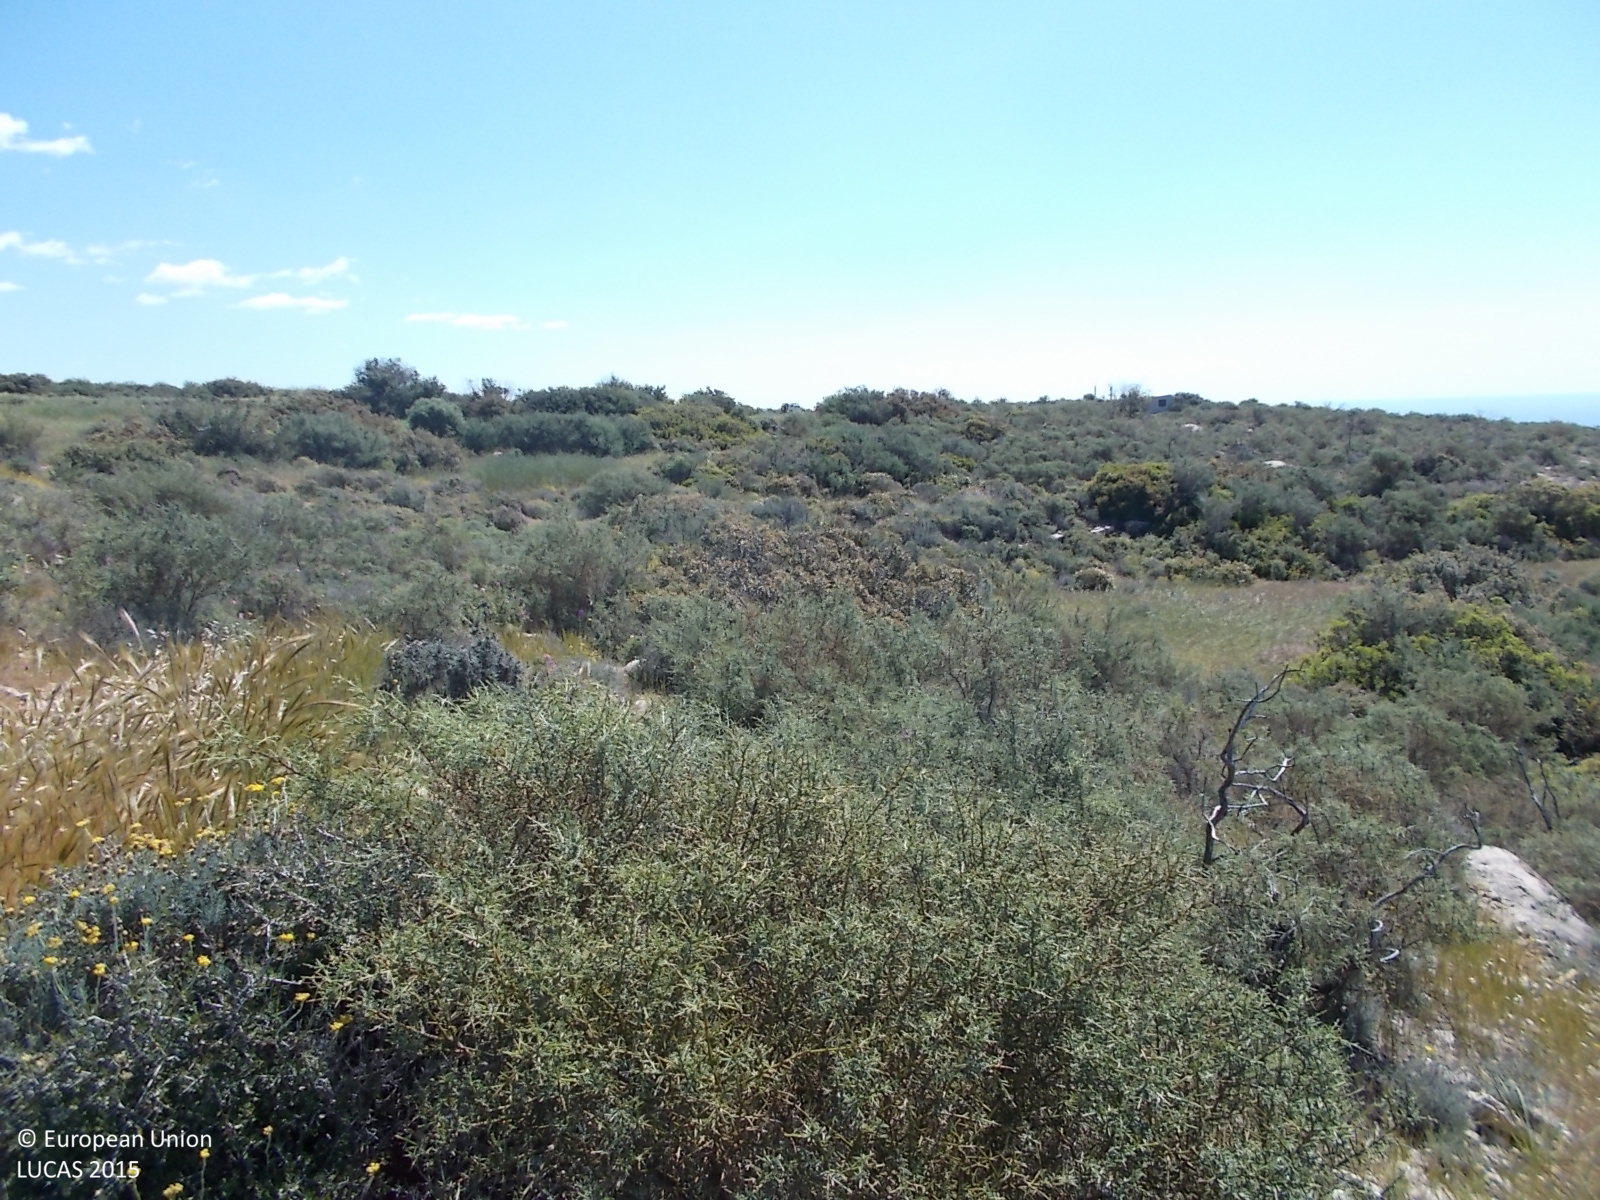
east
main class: Shrubland
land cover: Shrubland without tree cover
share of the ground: > 75 %
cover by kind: shrubs 100 %
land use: Semi-natural and natural areas not in use
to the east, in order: Shrubland without tree cover; Grassland without tree/shrub cover; Grassland with sparse tree/shrub cover; Paved roads, cycling and walking lanes; Shrubland without tree cover
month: April
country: CY
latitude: 34.7435
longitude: 33.0504
